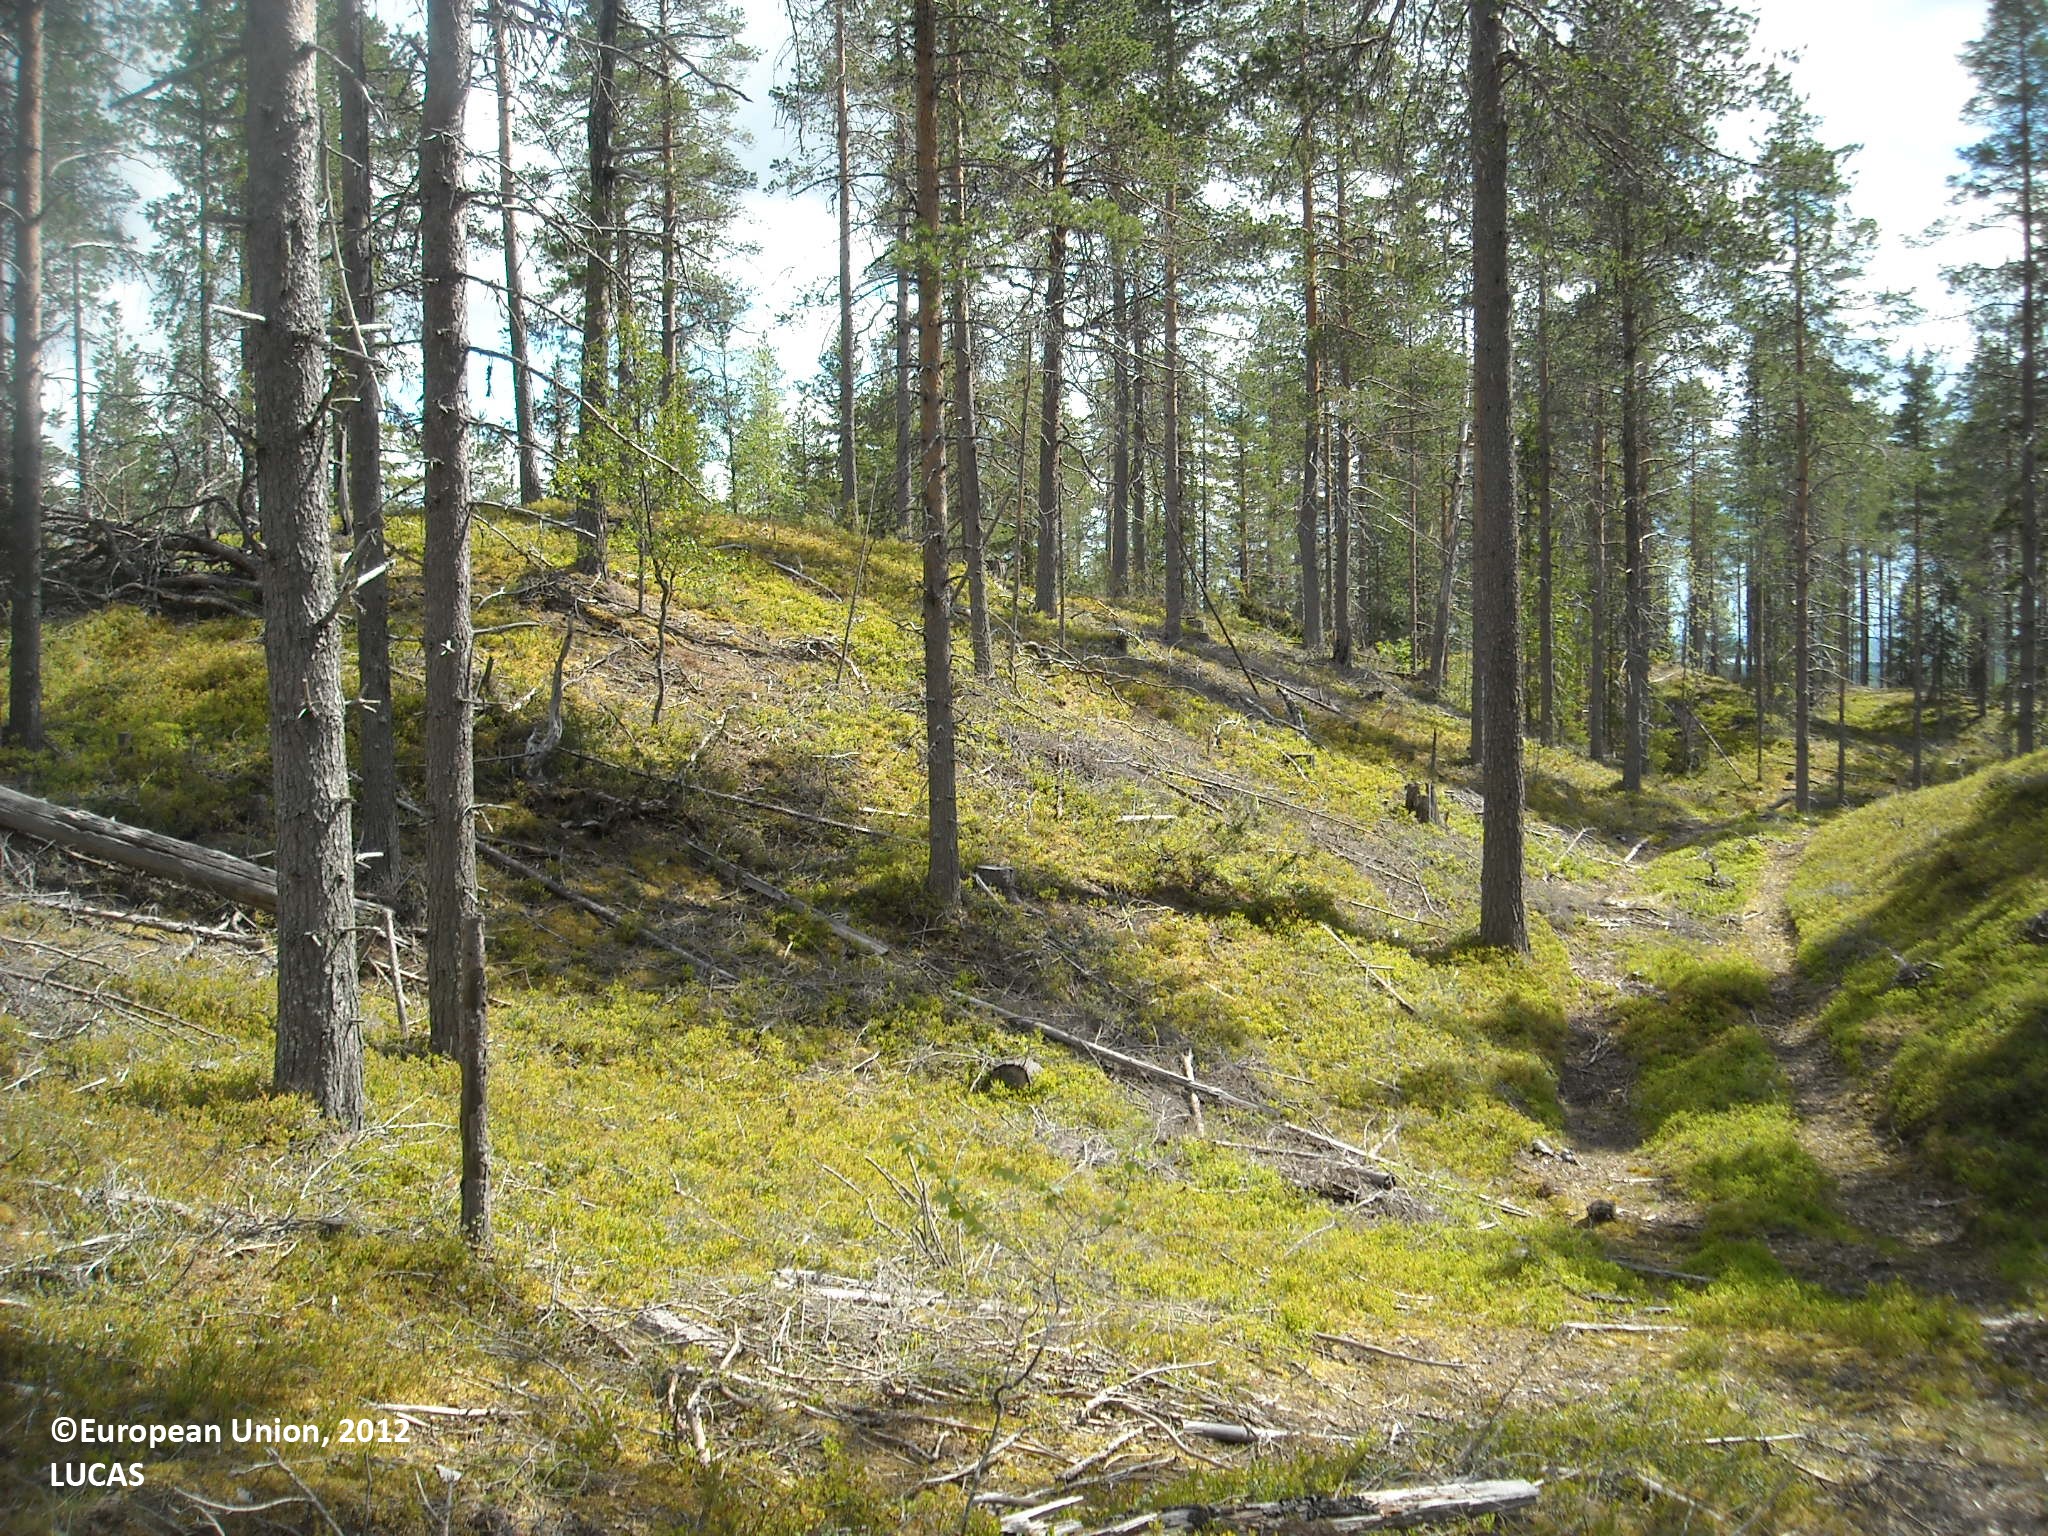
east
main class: Woodland
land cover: Pine dominated coniferous woodland
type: boreal forest
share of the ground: 50 - 75 %
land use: Forestry
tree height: > 5 m
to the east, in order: Pine dominated coniferous woodland; Other coniferous woodland; Shrubland with sparse tree cover; Spruce dominated coniferous woodland
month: June
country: FI
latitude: 65.3513
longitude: 27.8271
